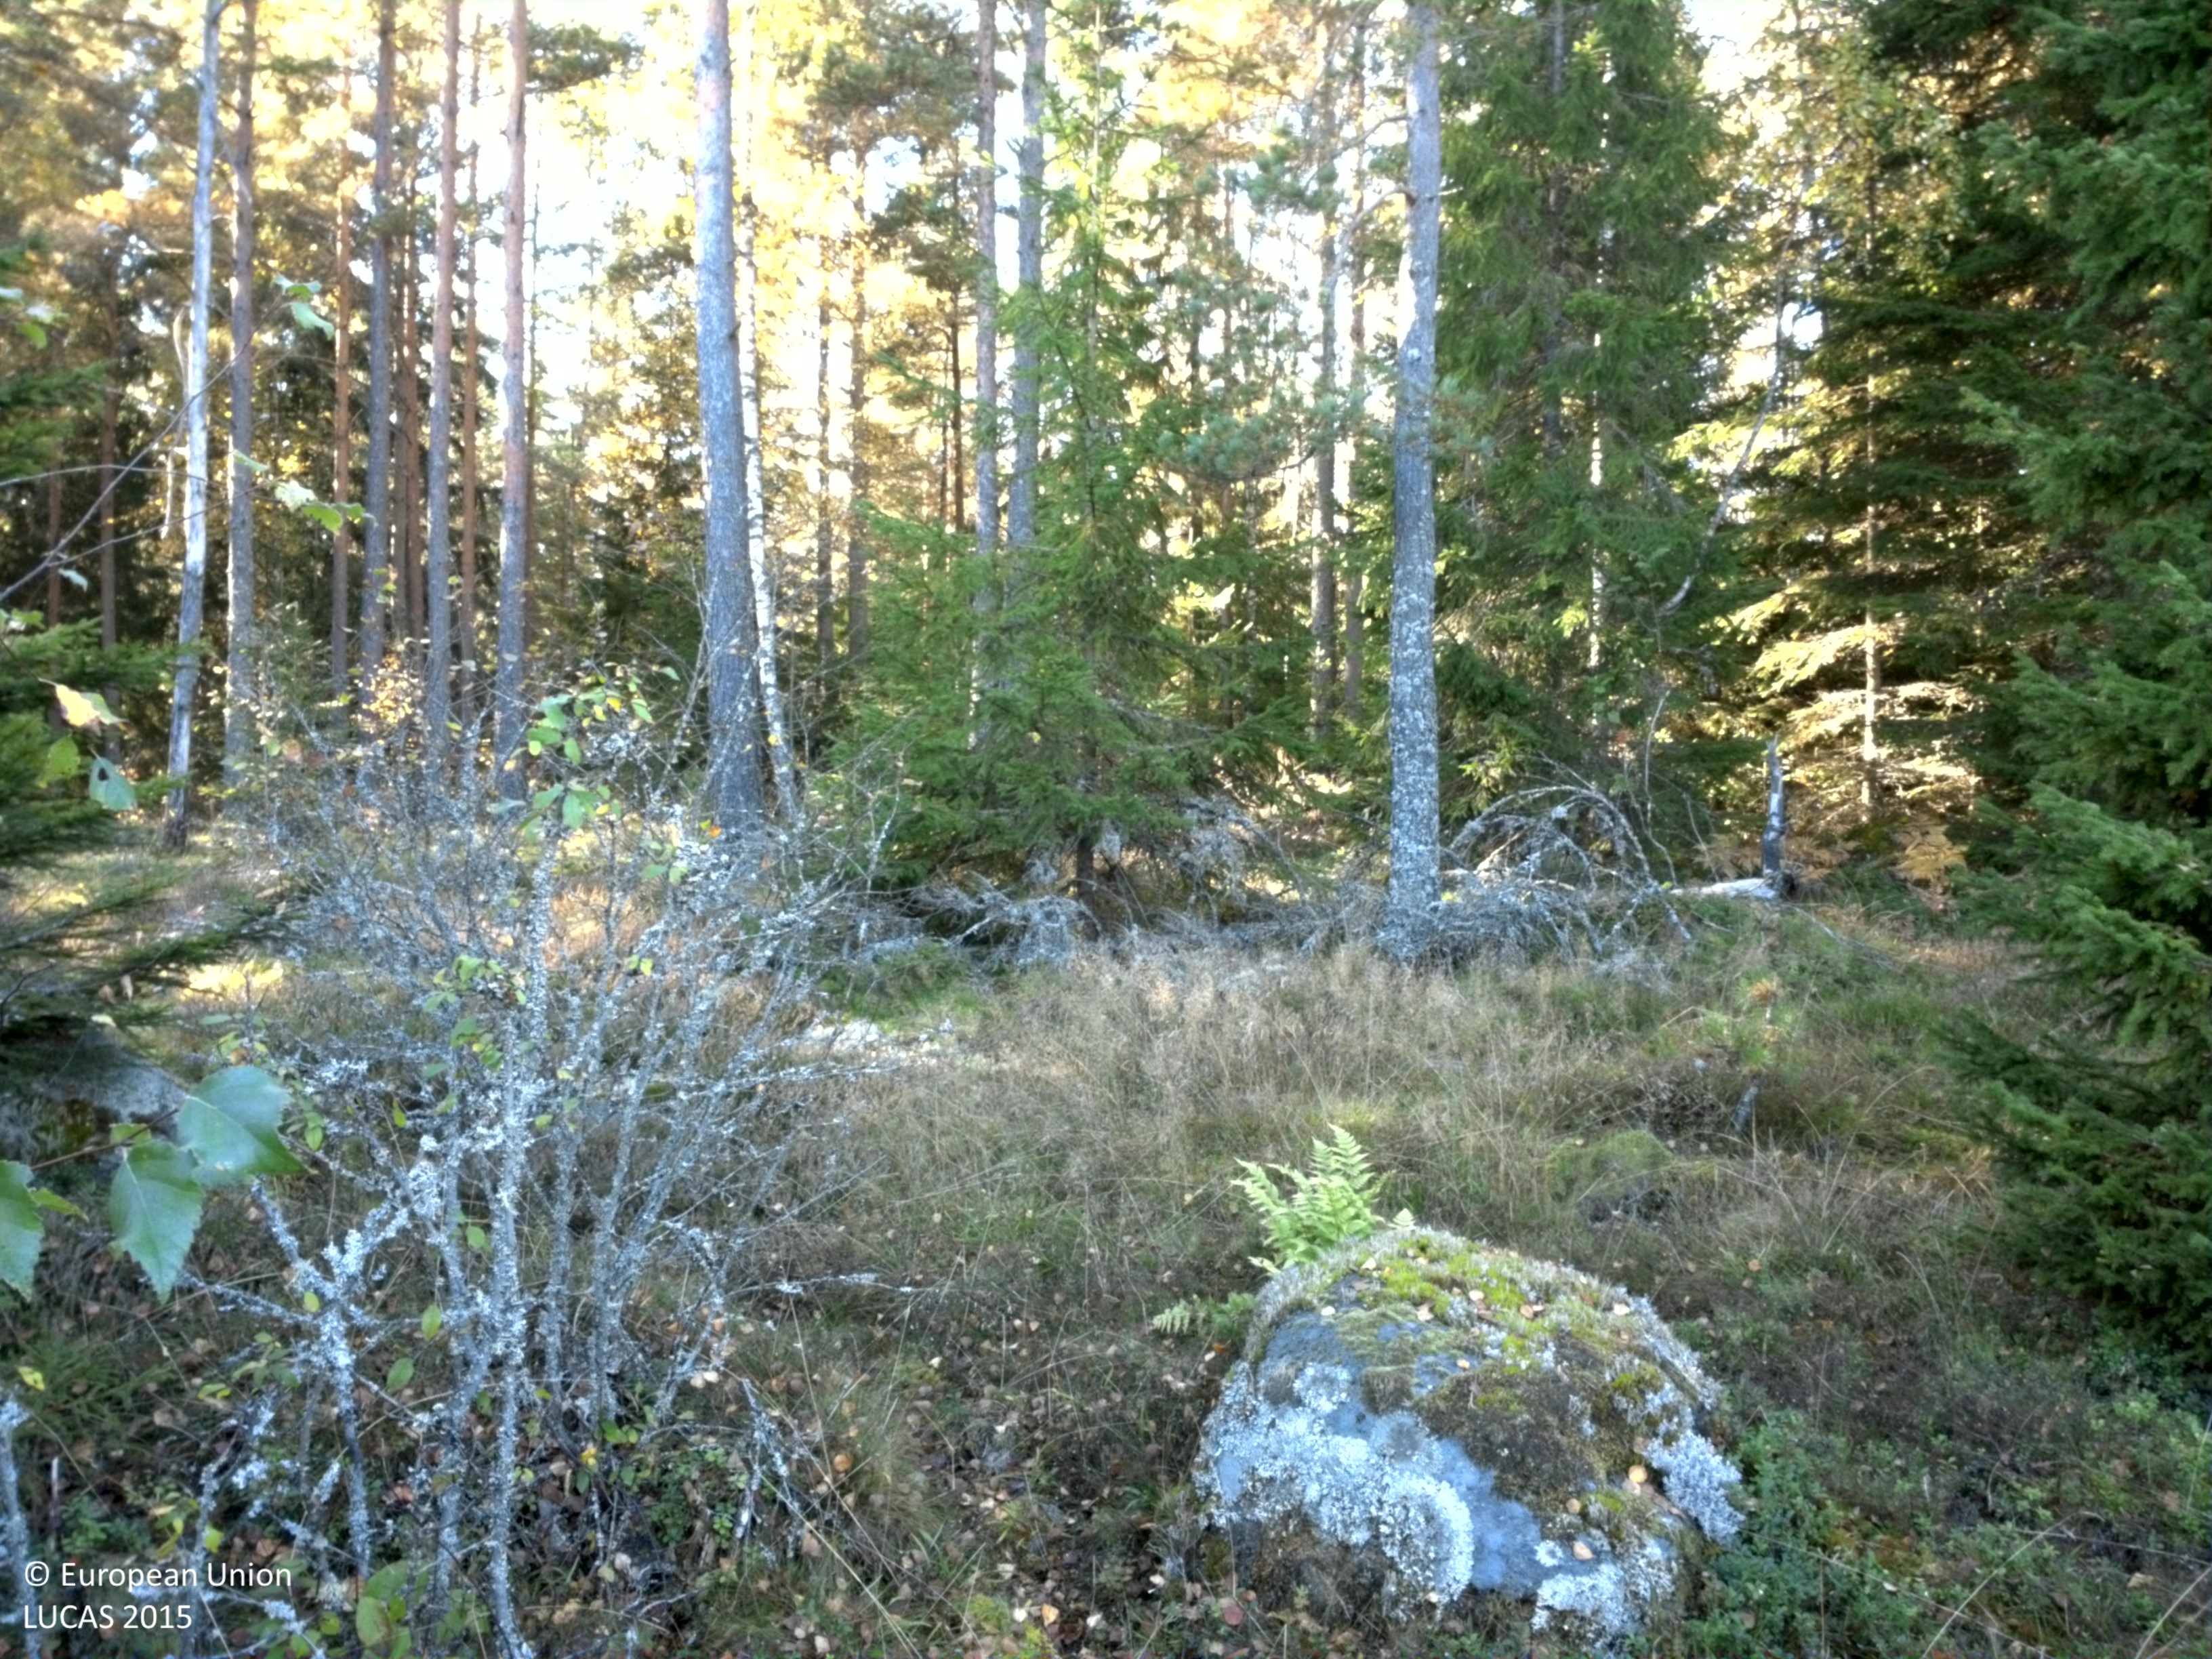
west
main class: Woodland
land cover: Spruce dominated mixed woodland
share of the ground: 10 - 25 %
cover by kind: shrubs 30 %, herbaceous plants 30 %, coniferous forest trees 15 %, lichens and mosses 15 %, broadleaved forest trees 10 %
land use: Forestry
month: September
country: SE
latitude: 59.1309
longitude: 14.0635
